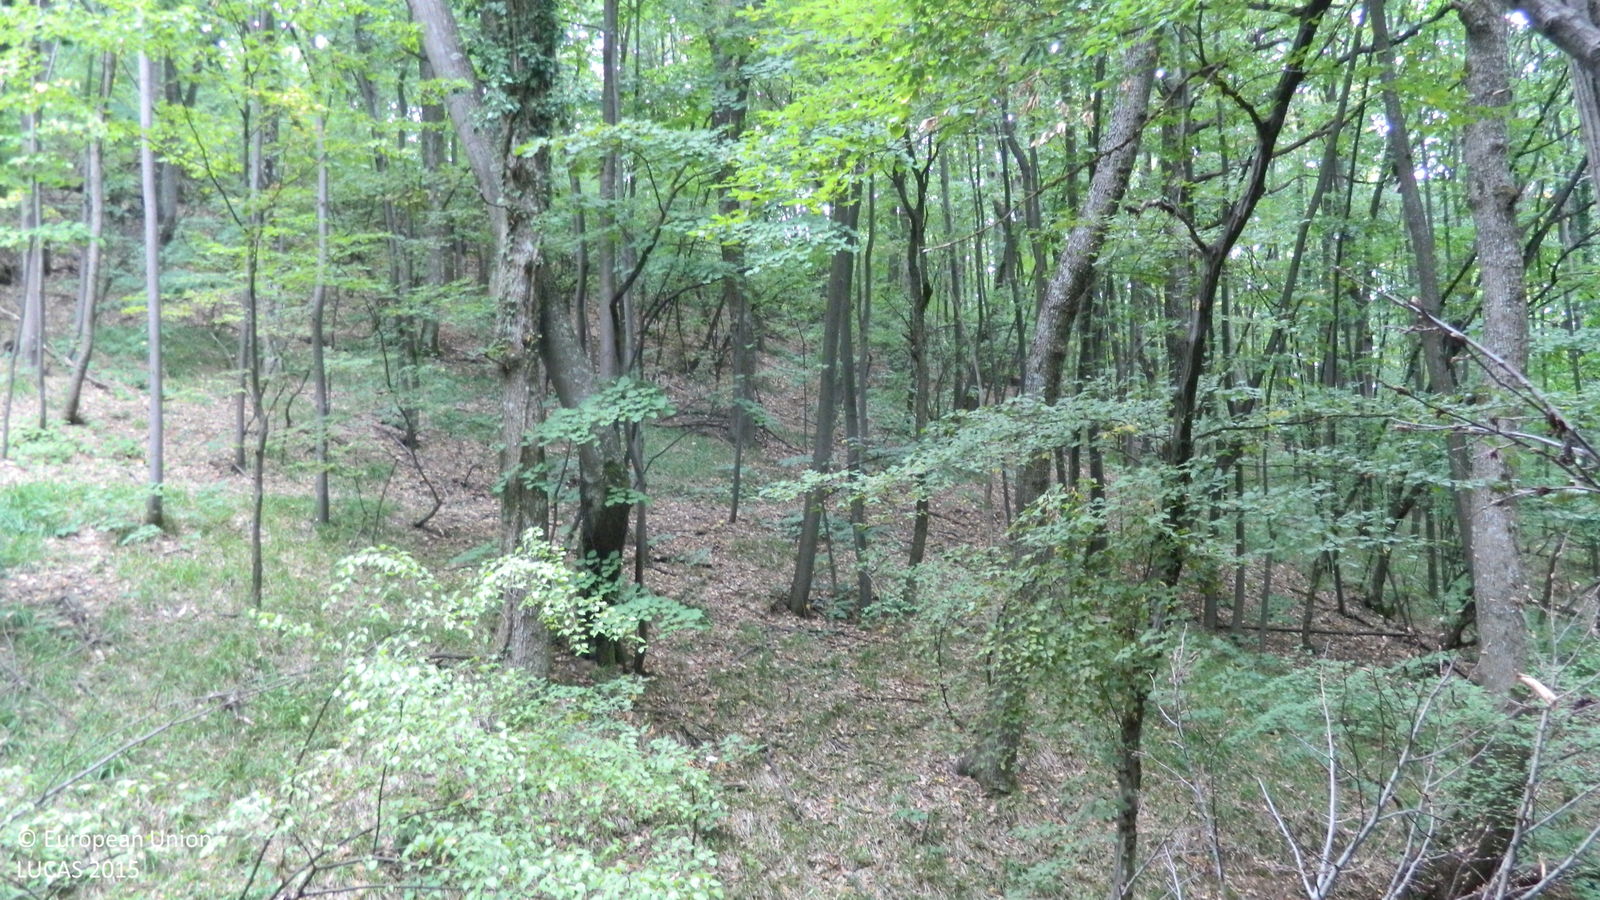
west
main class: Woodland
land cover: Broadleaved woodland
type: mesophytic deciduous forest
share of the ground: > 75 %
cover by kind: broadleaved forest trees 100 %
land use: Forestry
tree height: > 5 m
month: August
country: BG
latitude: 41.7309
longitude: 25.8284
